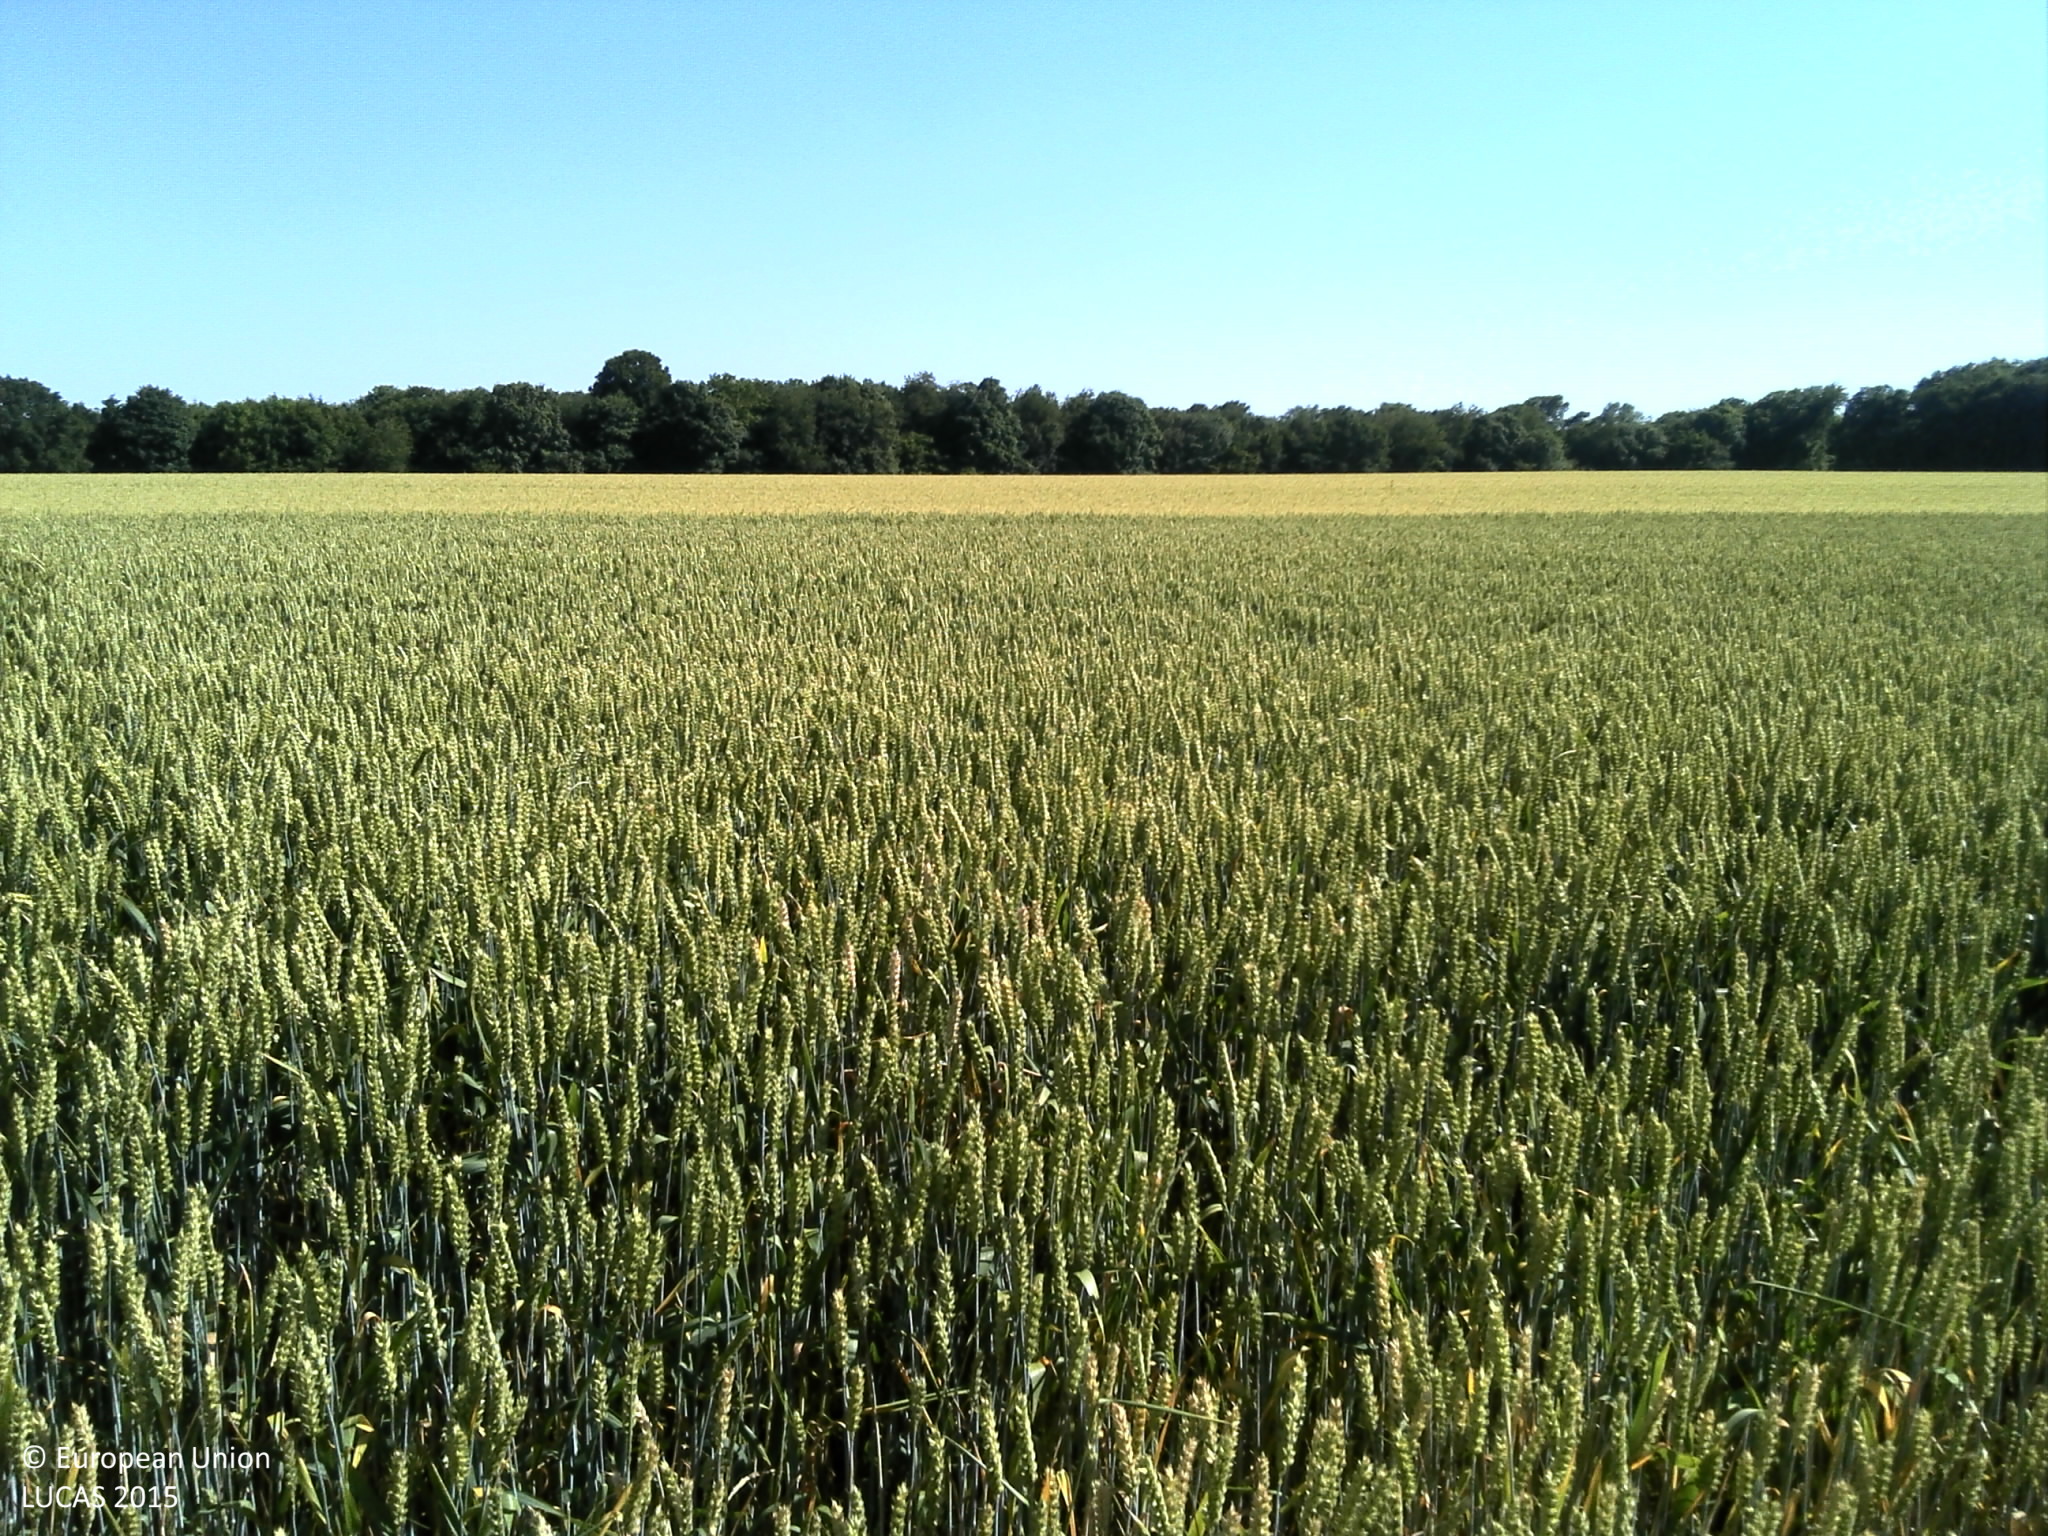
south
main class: Cropland
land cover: Rape and turnip rape
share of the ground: > 75 %
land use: Agriculture (excluding fallow land and kitchen gardens)
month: June
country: FR
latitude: 49.4124
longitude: 6.0160
